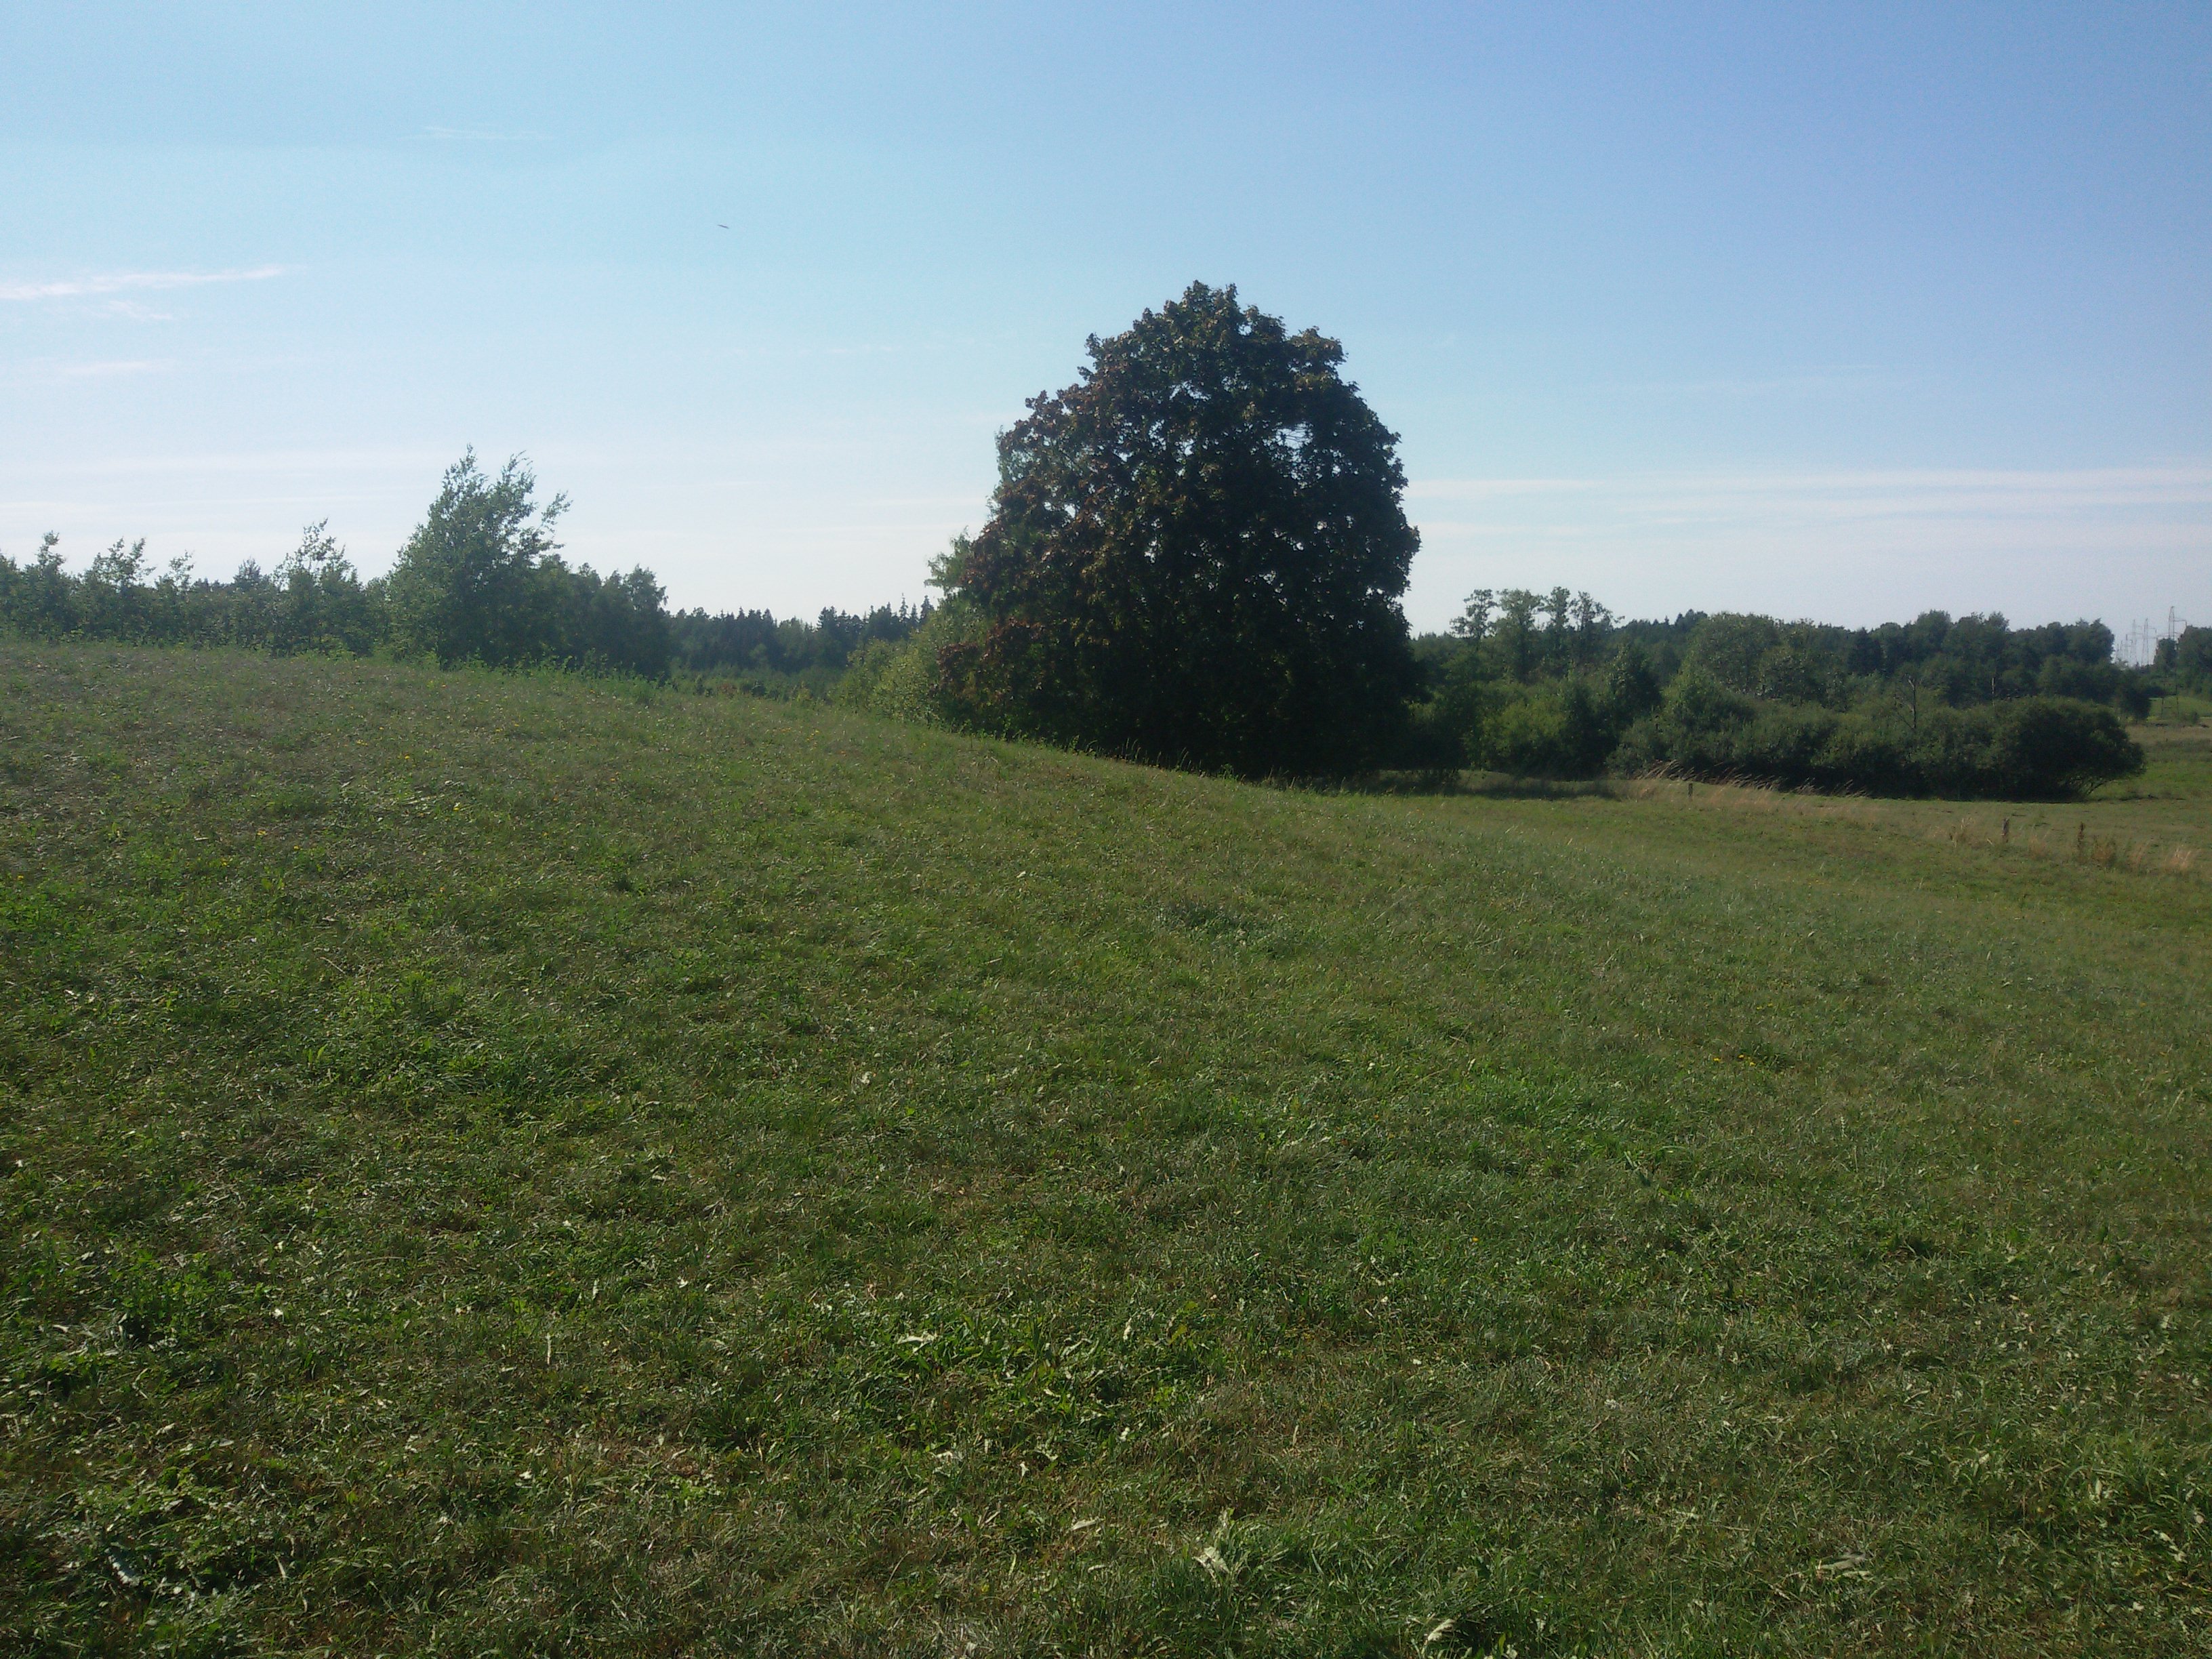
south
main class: Grassland
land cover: Grassland without tree/shrub cover
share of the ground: > 75 %
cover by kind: herbaceous plants 100 %
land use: Agriculture (excluding fallow land and kitchen gardens)
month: August
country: PL
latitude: 53.9207
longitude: 21.1449
